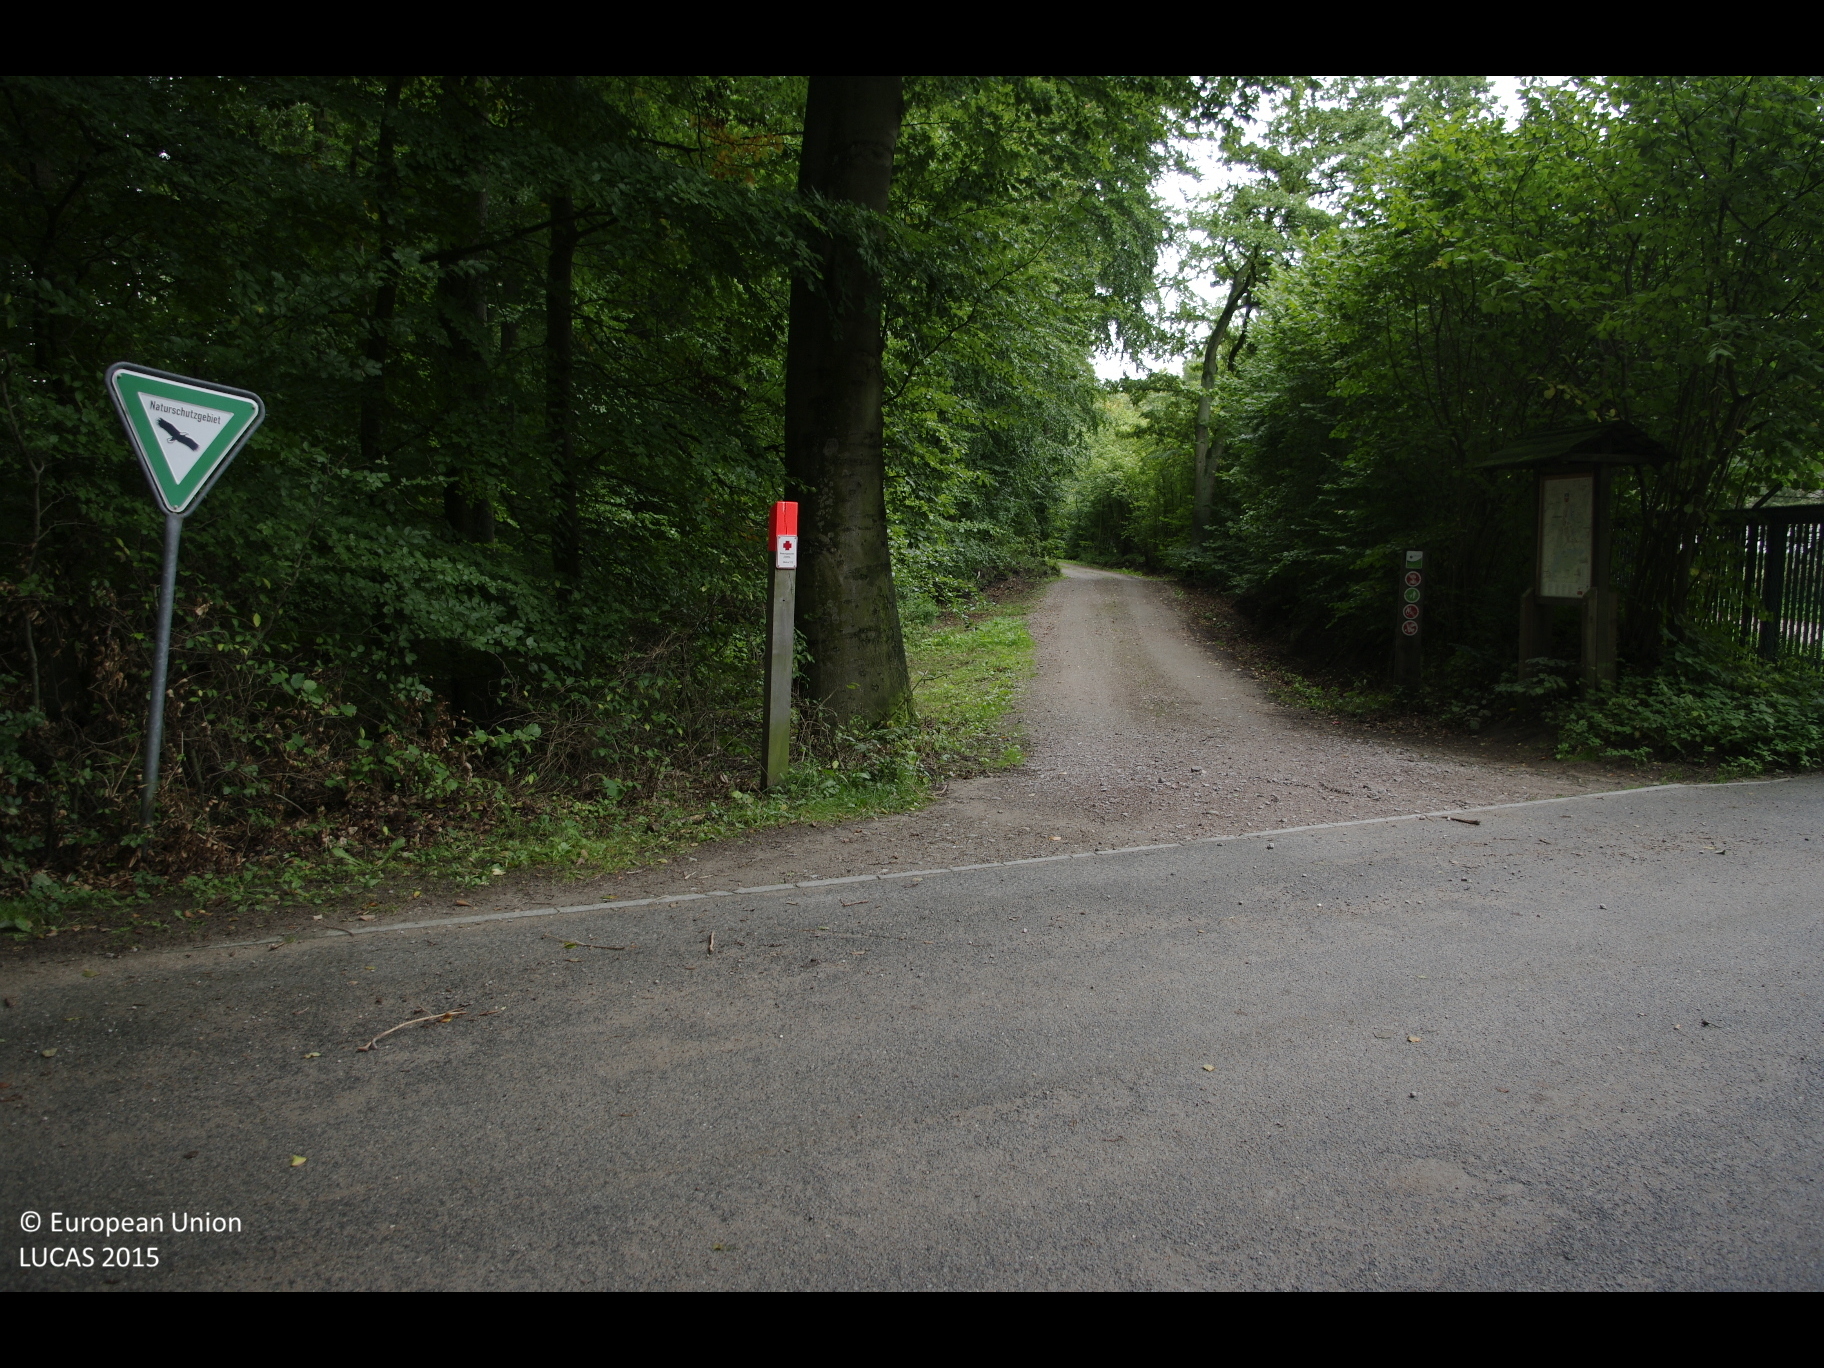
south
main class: Cropland
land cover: Apple fruit
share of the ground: 25 - 50 %
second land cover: Grassland without tree/shrub cover
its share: > 75 %
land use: Agriculture (excluding fallow land and kitchen gardens)
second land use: Amenities, museums, leisure
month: September
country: DE
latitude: 53.6529
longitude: 10.3780
